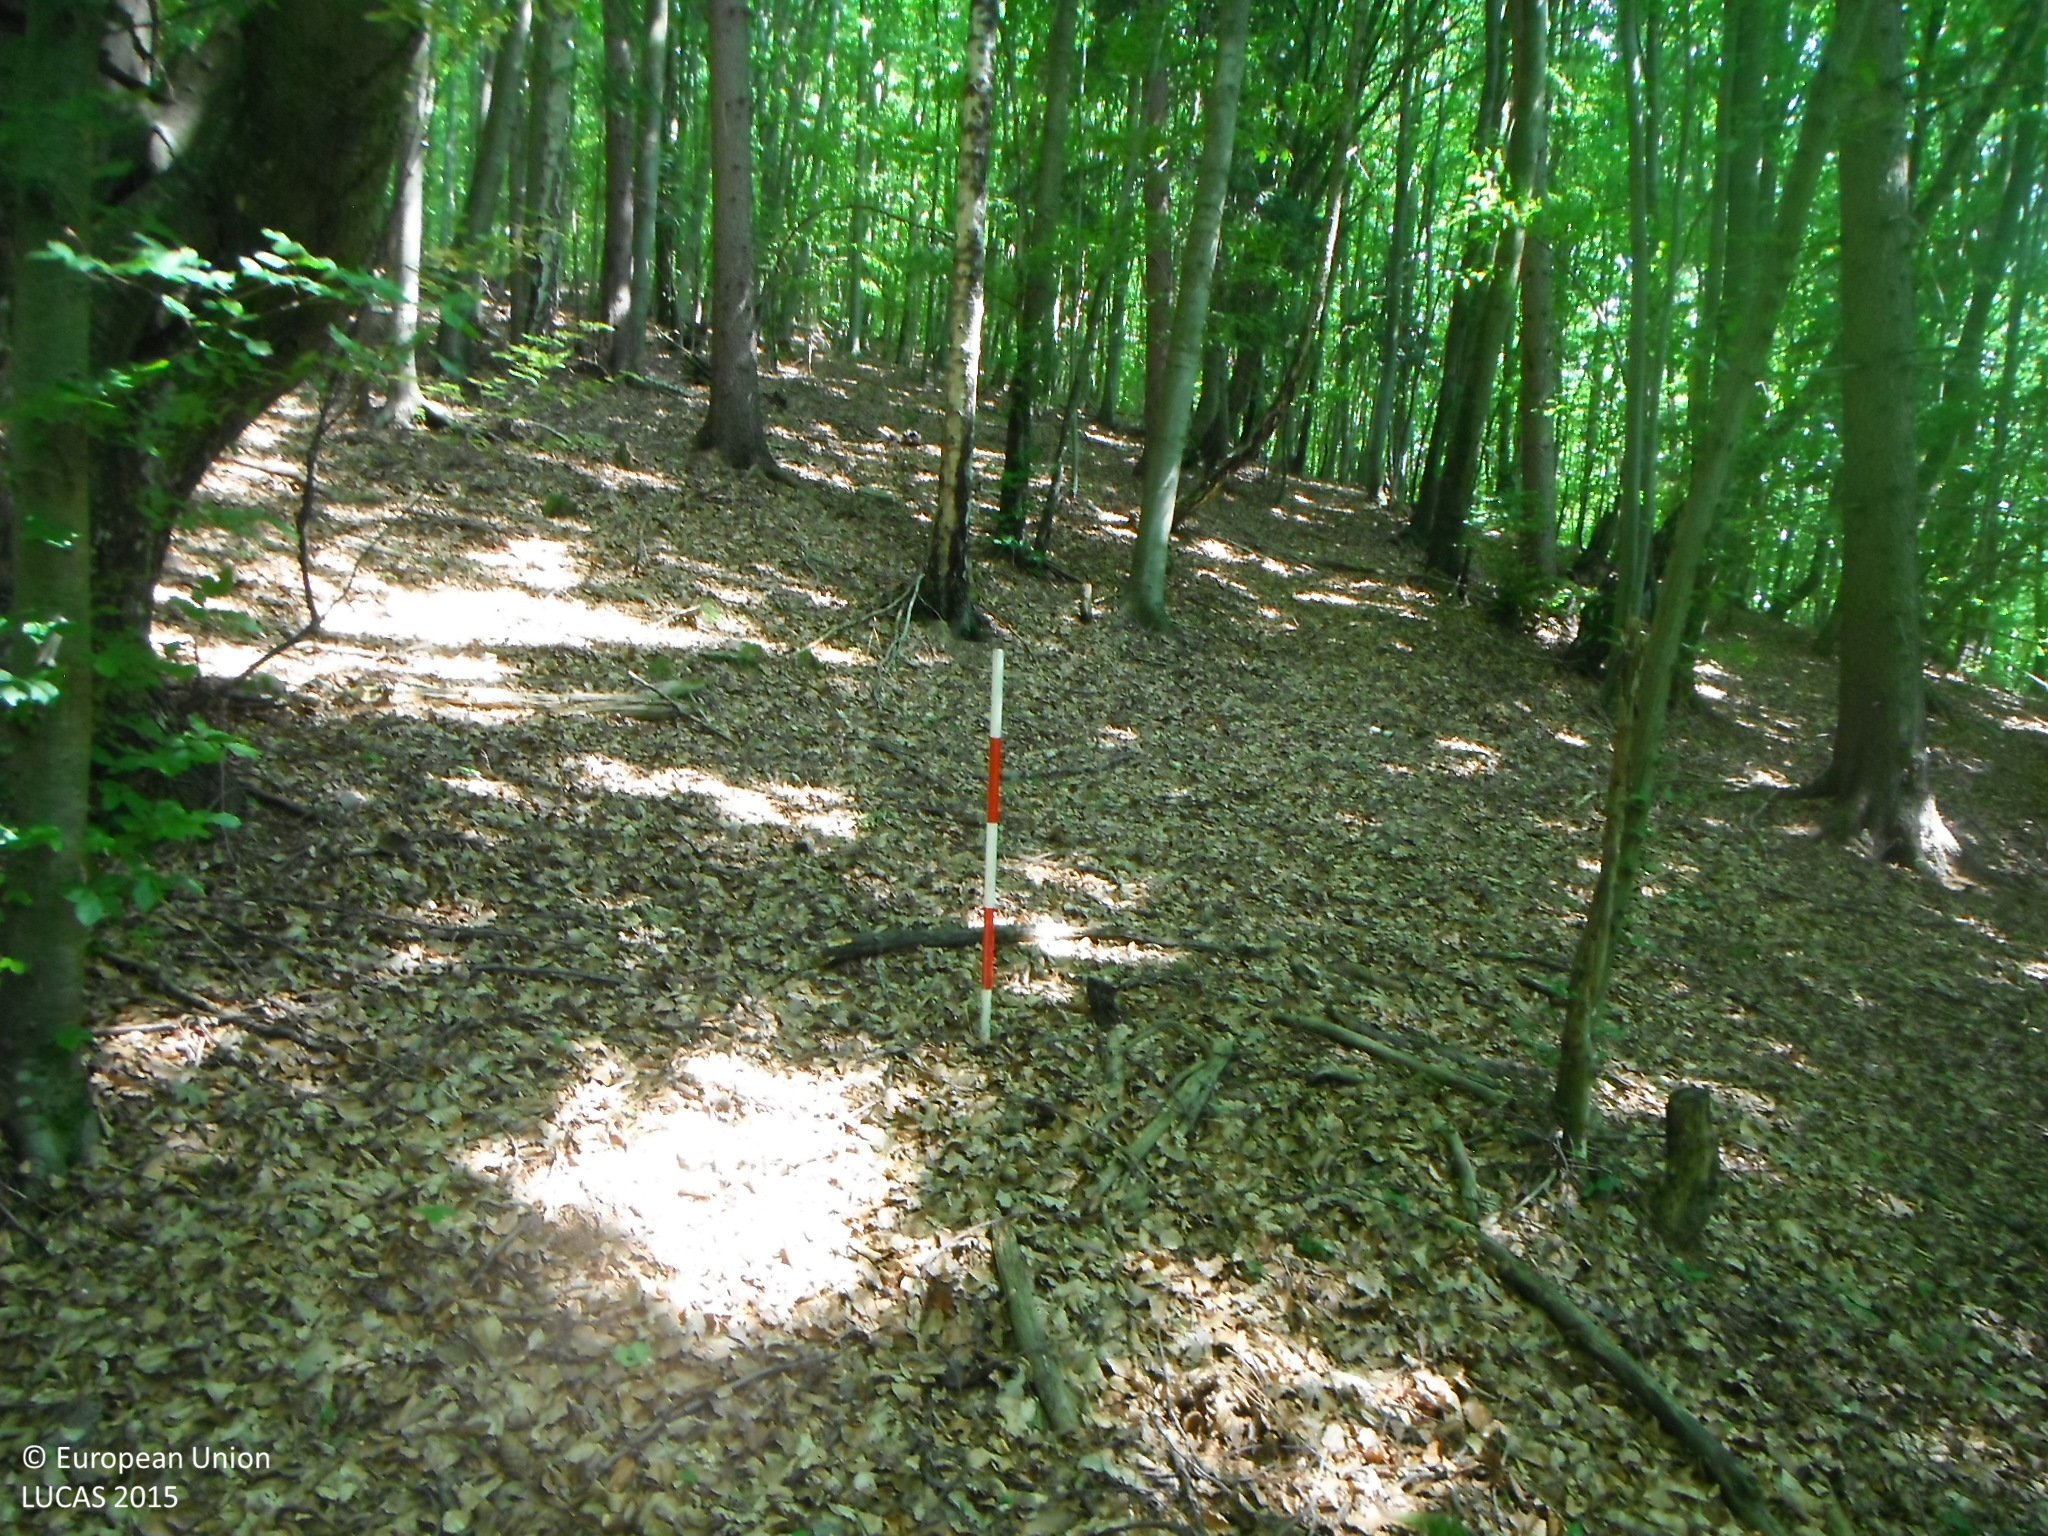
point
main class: Woodland
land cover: Spruce dominated mixed woodland
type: mountainous beech forest
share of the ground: > 75 %
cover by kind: broadleaved forest trees 70 %, coniferous forest trees 30 %
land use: Forestry
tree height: > 5 m
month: June
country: SK
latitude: 48.6808
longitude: 19.3001
